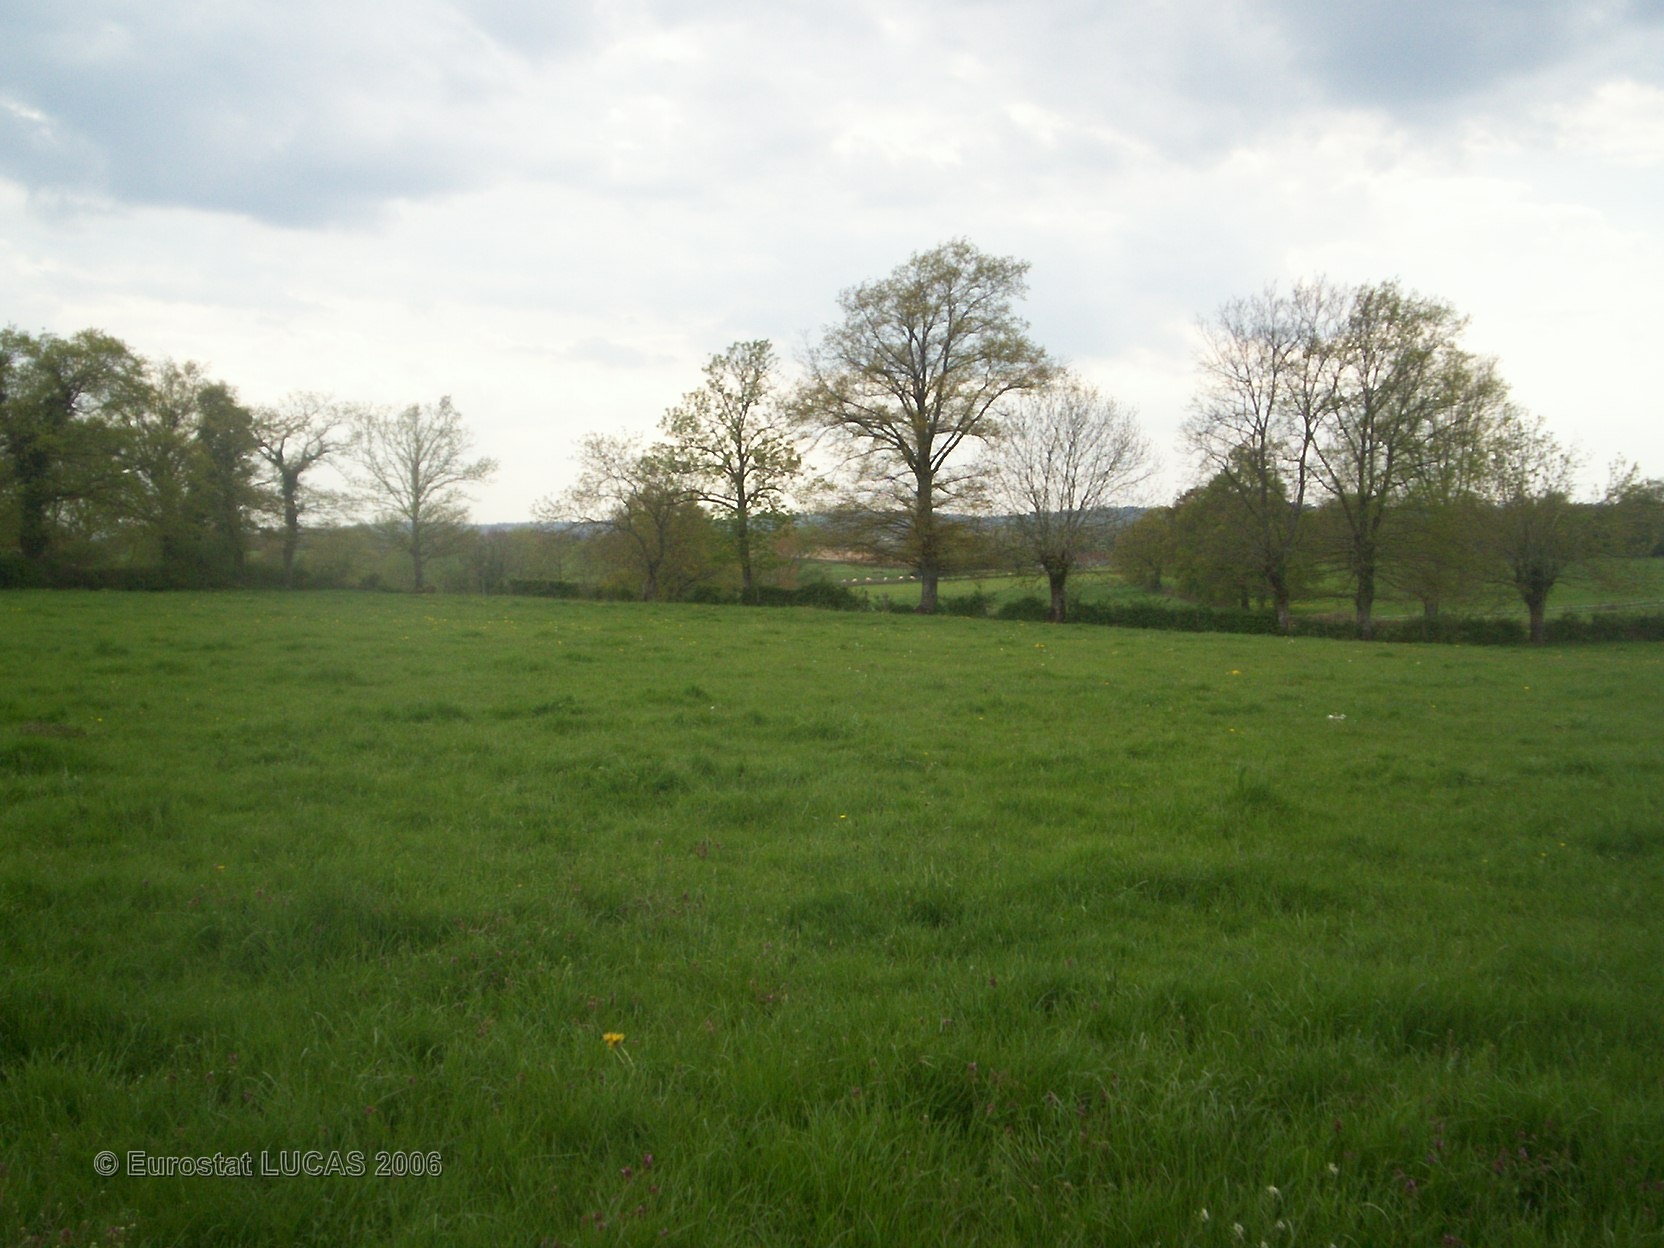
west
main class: Grassland
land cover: Grassland with sparse tree/shrub cover
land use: Agriculture (excluding fallow land and kitchen gardens)
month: May
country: FR
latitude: 46.4184
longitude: 3.1151
